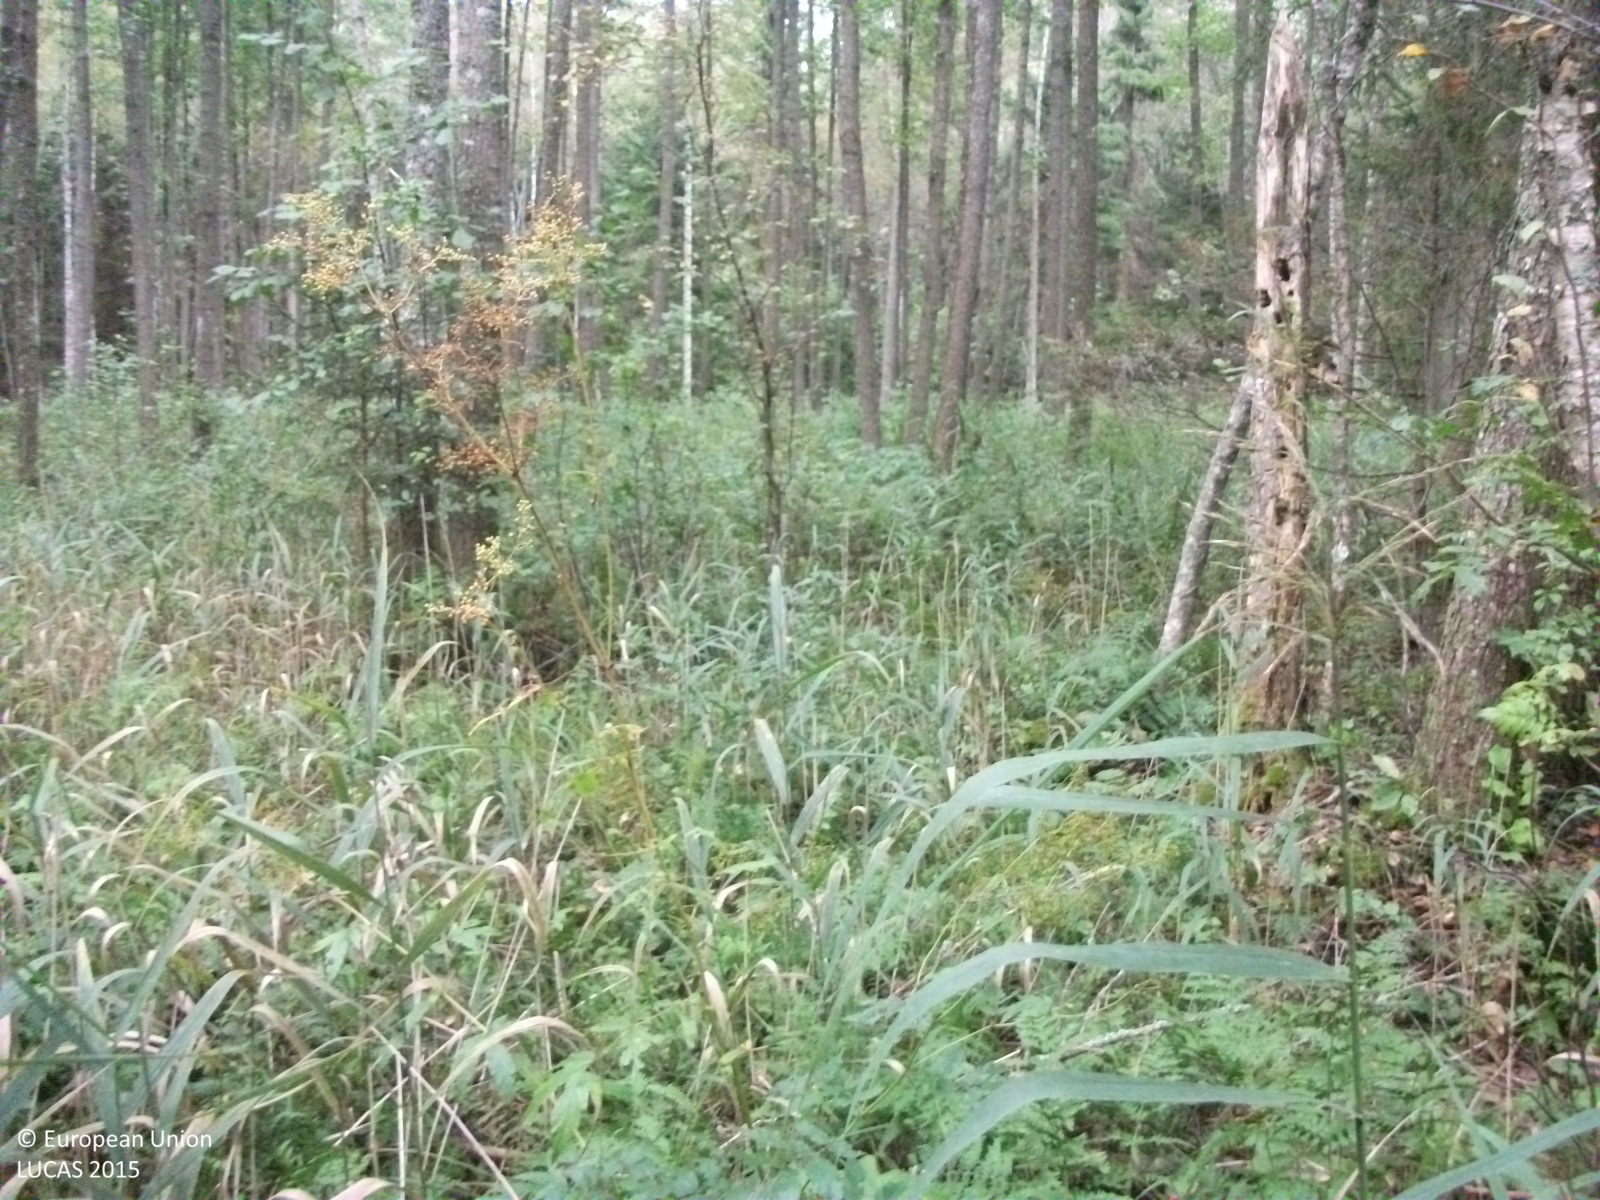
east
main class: Woodland
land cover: Broadleaved woodland
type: non-riverine alder, birch or aspen forest
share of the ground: > 75 %
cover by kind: broadleaved forest trees 90 %, shrubs 5 %, herbaceous plants 5 %
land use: Forestry
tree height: > 5 m
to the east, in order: Ditches and canals; Shruby margins; Broadleaved woodland; Spruce dominated coniferous woodland; Spruce dominated mixed woodland; Ditches and canals; Grass margins; Paved roads, cycling and walking lanes; Grass margins; Ditches and canals; Spruce dominated mixed woodland; Other mixed woodland
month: September
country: LV
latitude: 57.7505
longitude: 24.5579
